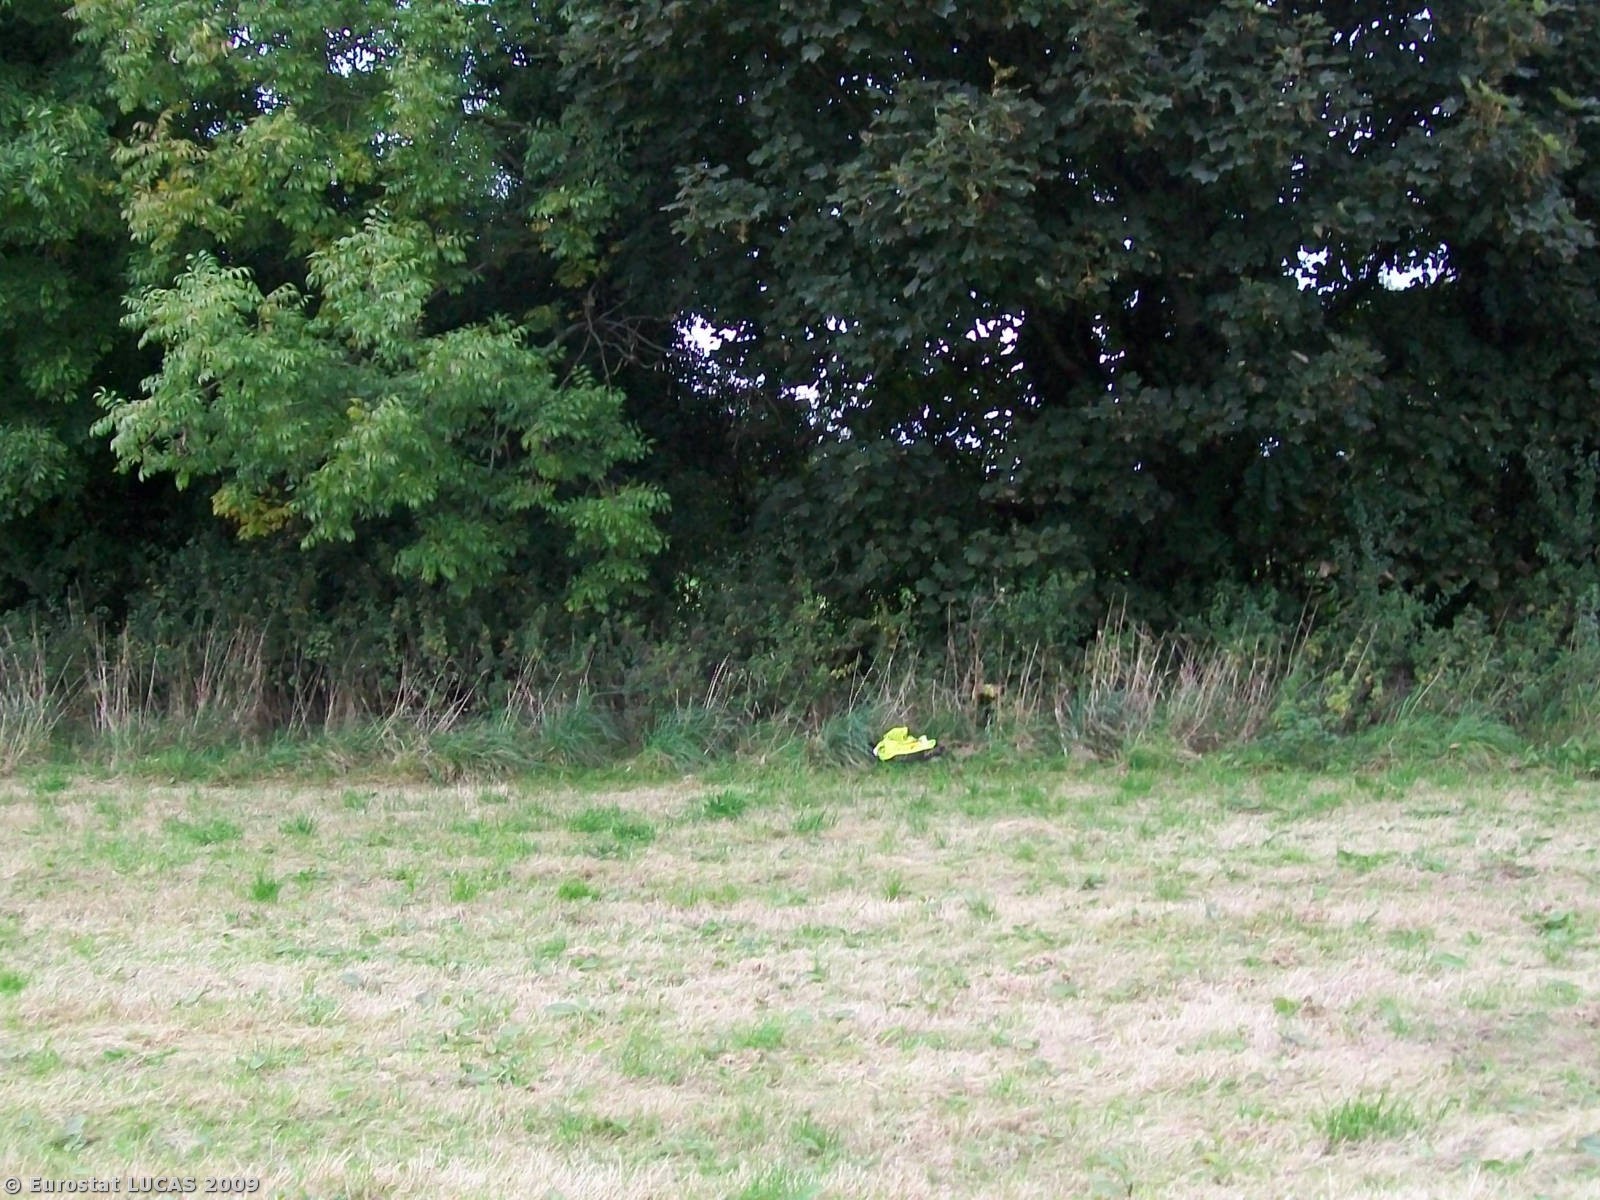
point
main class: Grassland
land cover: Grassland without tree/shrub cover
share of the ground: > 75 %
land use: Agriculture (excluding fallow land and kitchen gardens)
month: September
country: IE
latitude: 53.1447
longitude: -8.3533
